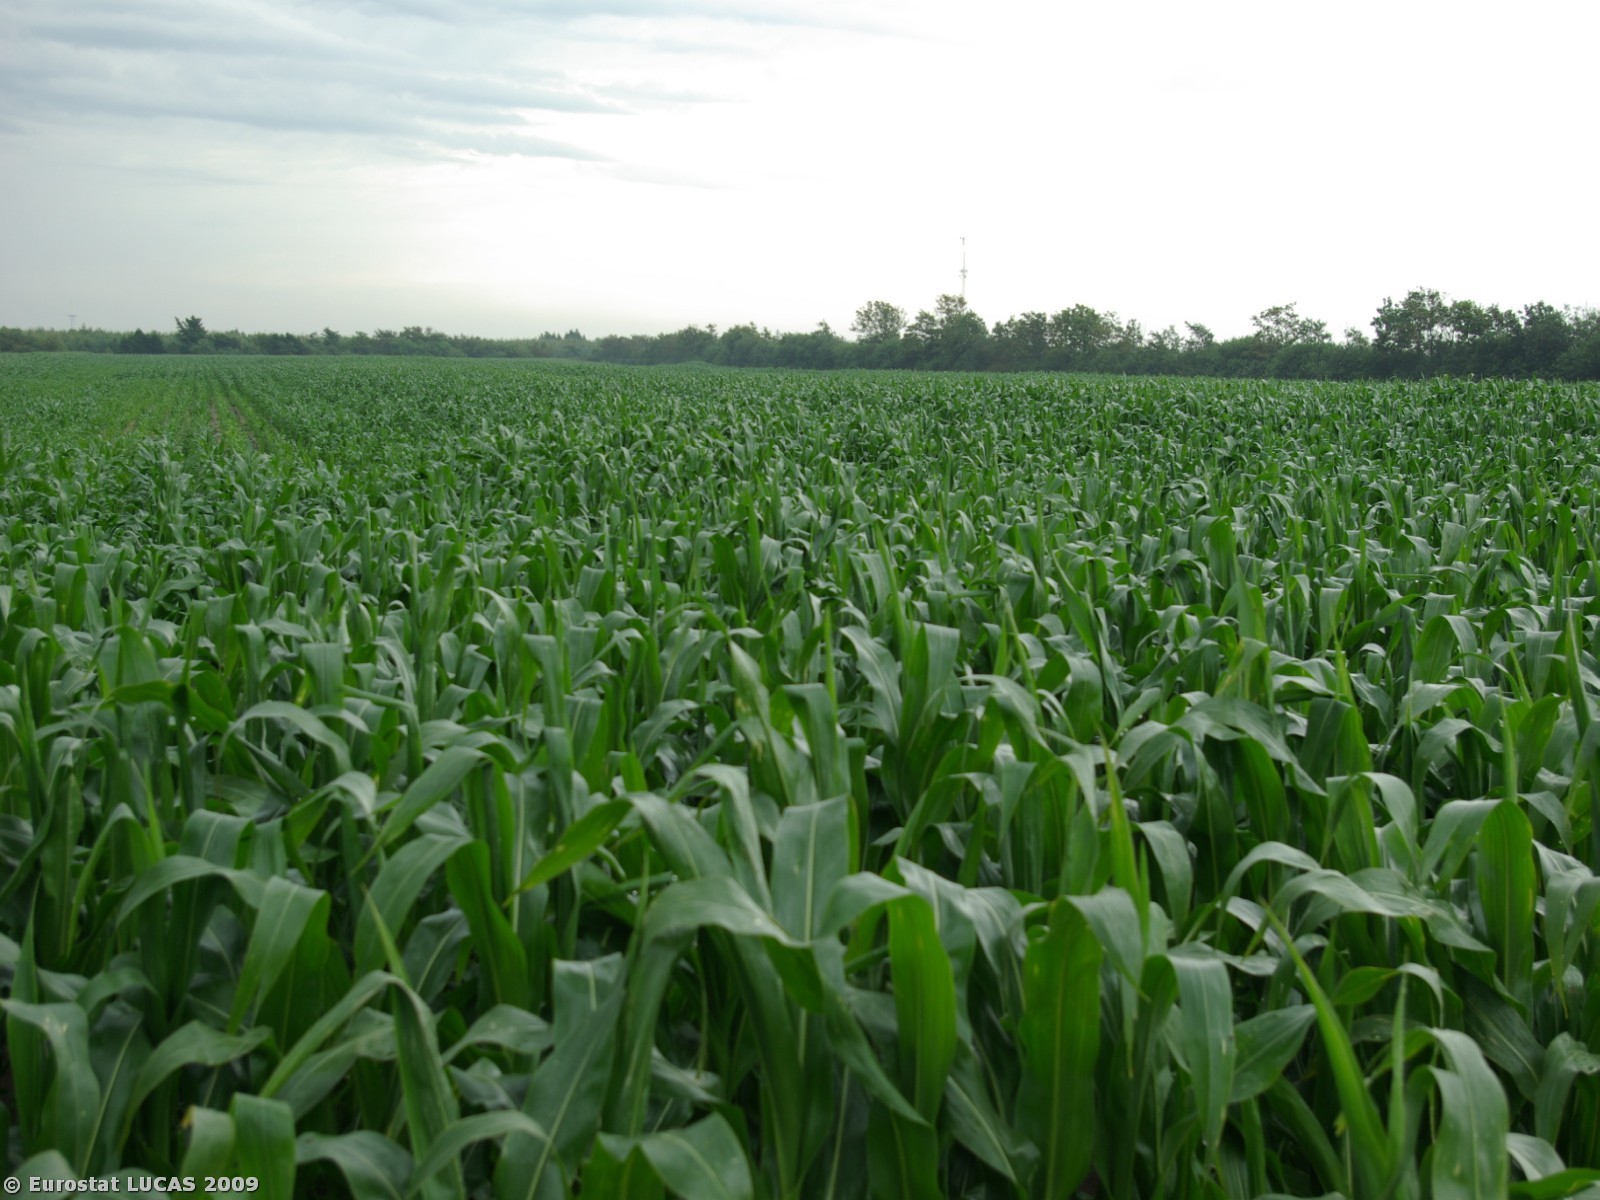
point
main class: Cropland
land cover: Maize
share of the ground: > 75 %
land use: Agriculture (excluding fallow land and kitchen gardens)
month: July
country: DK
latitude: 55.2287
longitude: 8.7275
